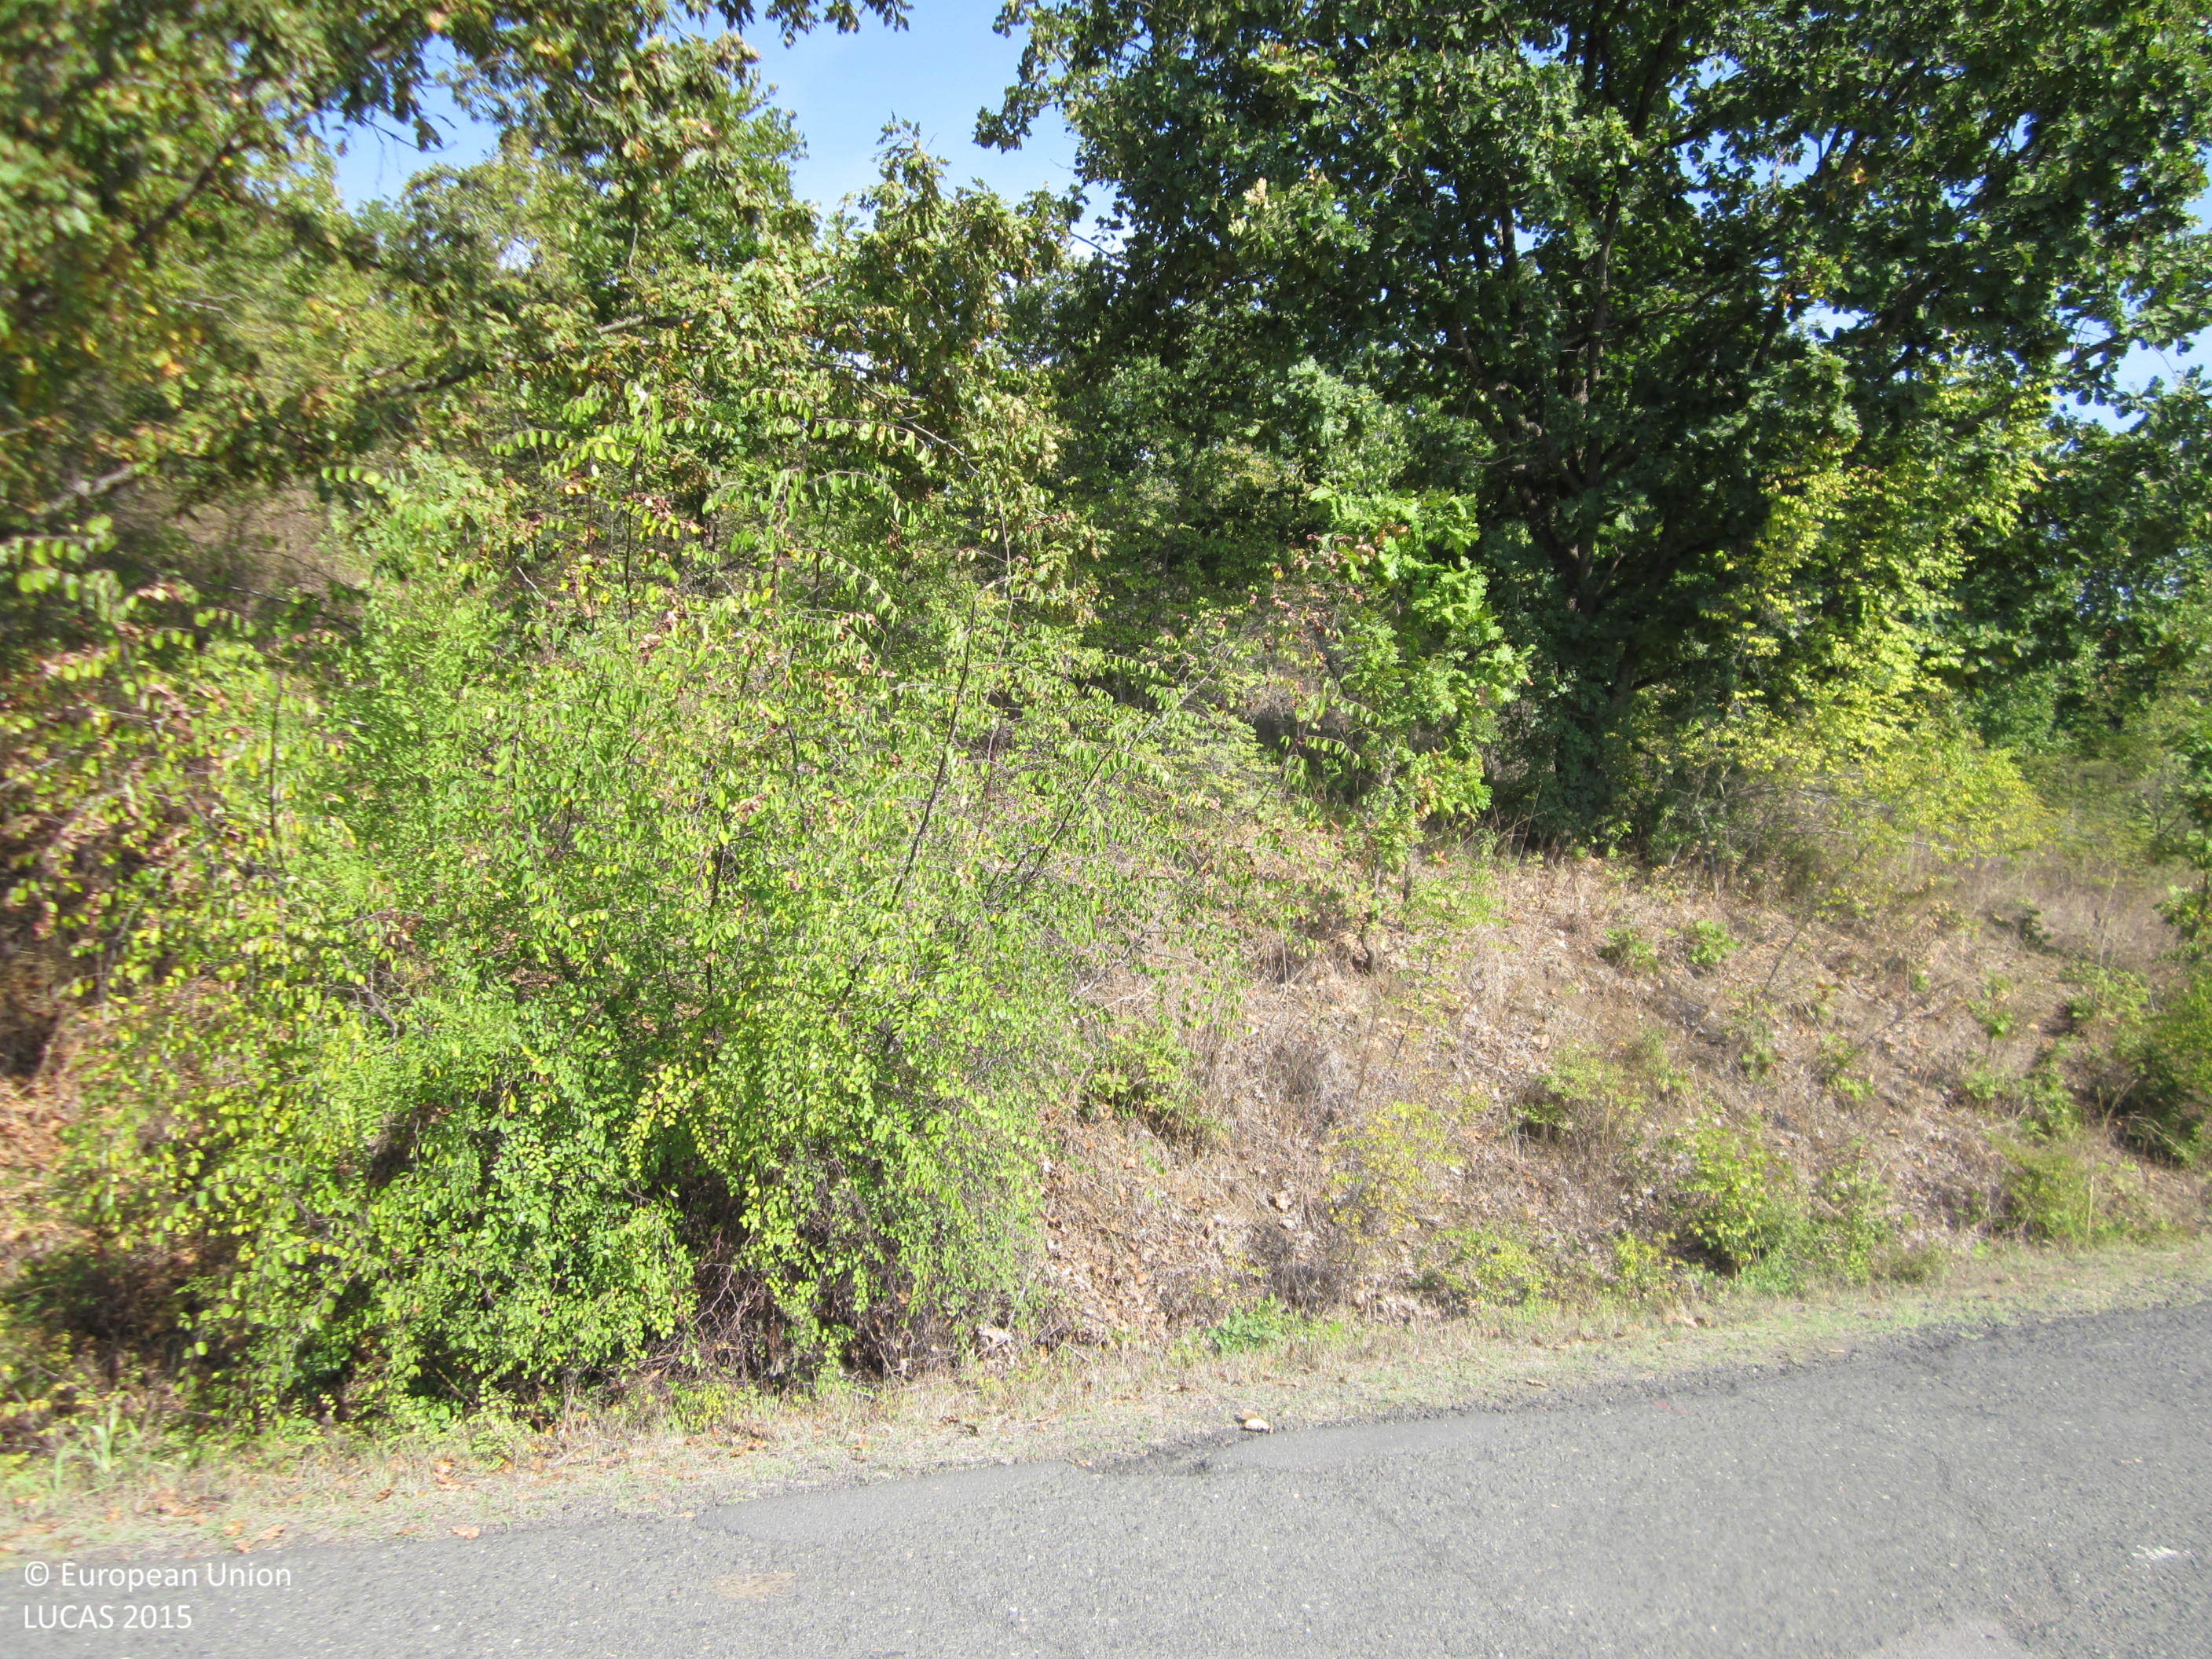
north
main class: Shrubland
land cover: Shrubland with sparse tree cover
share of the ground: > 75 %
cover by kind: shrubs 85 %, broadleaved forest trees 5 %, herbaceous plants 5 %, consolidated bare surface 5 %
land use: Semi-natural and natural areas not in use
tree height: < 5 m
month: September
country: BG
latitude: 42.1983
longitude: 27.7409
